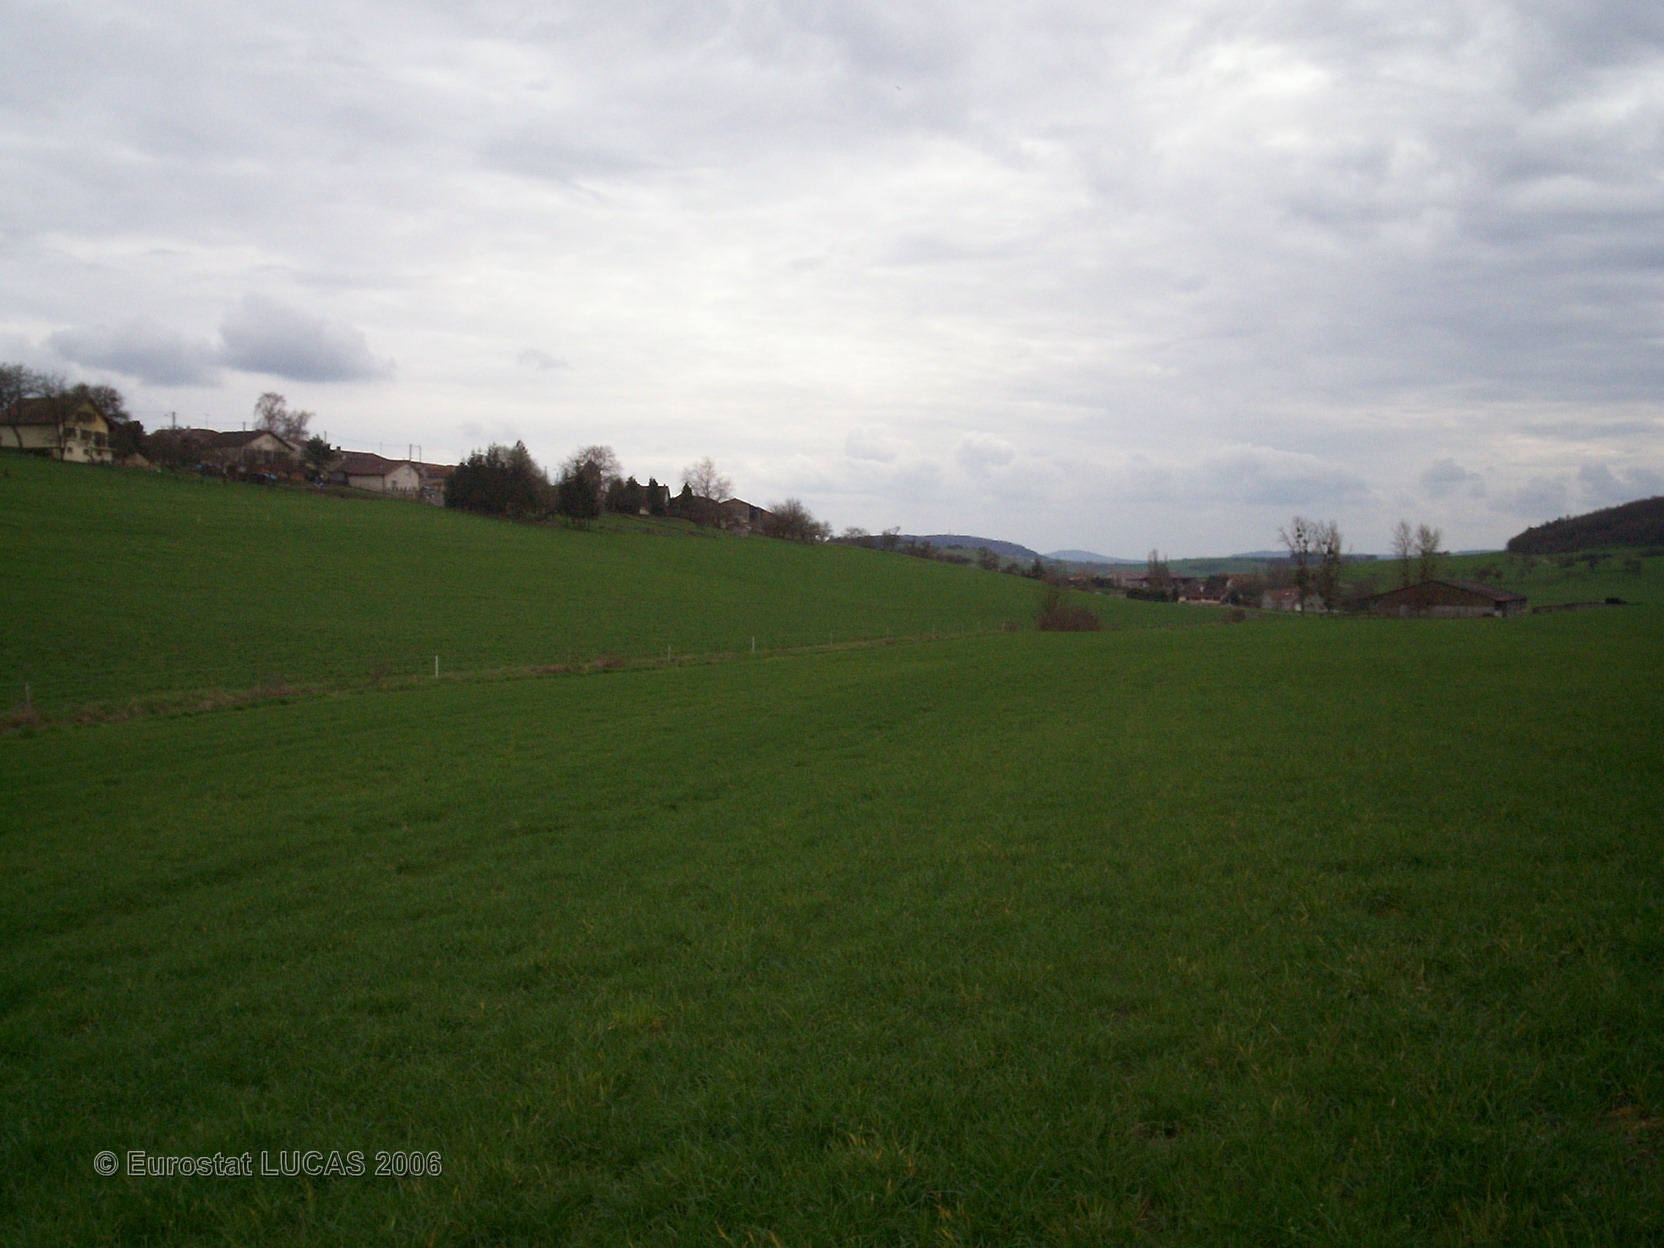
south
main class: Cropland
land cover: Other leguminous and mixtures for fodder
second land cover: Clovers
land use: Agriculture (excluding fallow land and kitchen gardens)
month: April
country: FR
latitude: 48.2571
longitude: 5.9459
